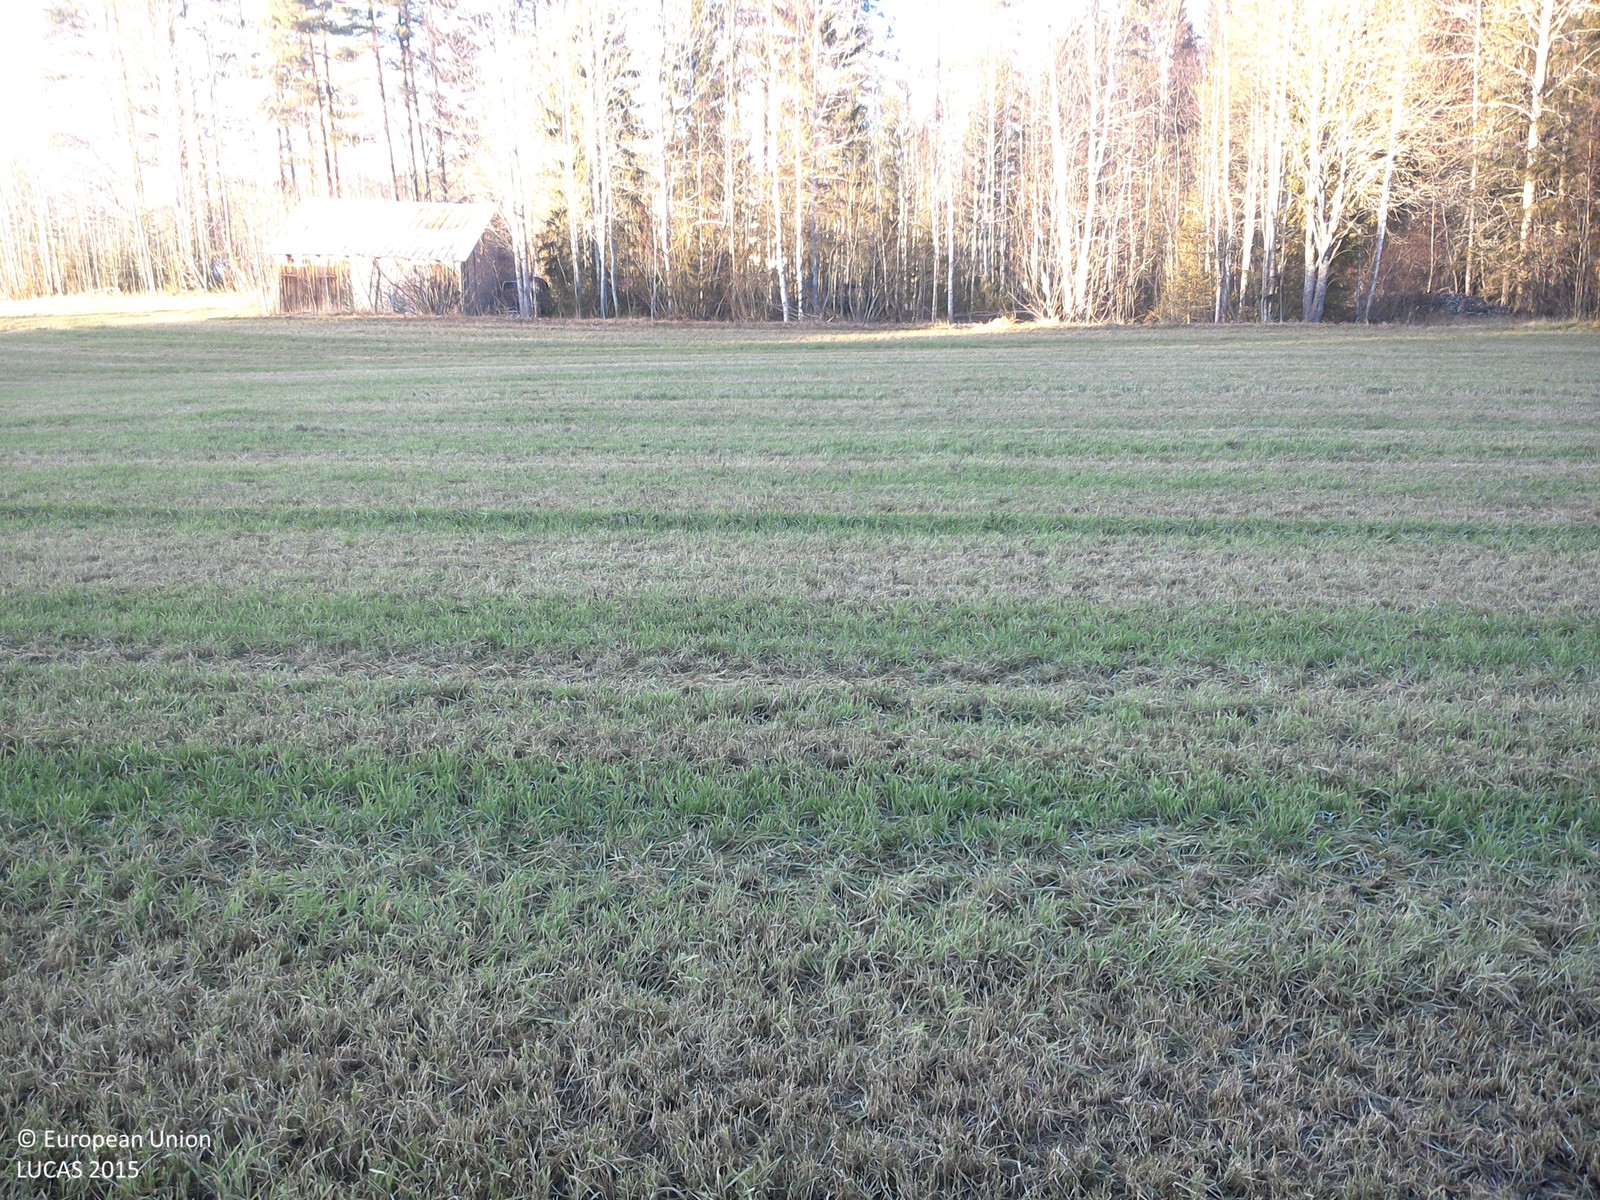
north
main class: Cropland
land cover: Temporary grasslands
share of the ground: > 75 %
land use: Agriculture (excluding fallow land and kitchen gardens)
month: October
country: SE
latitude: 63.8699
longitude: 19.6037
